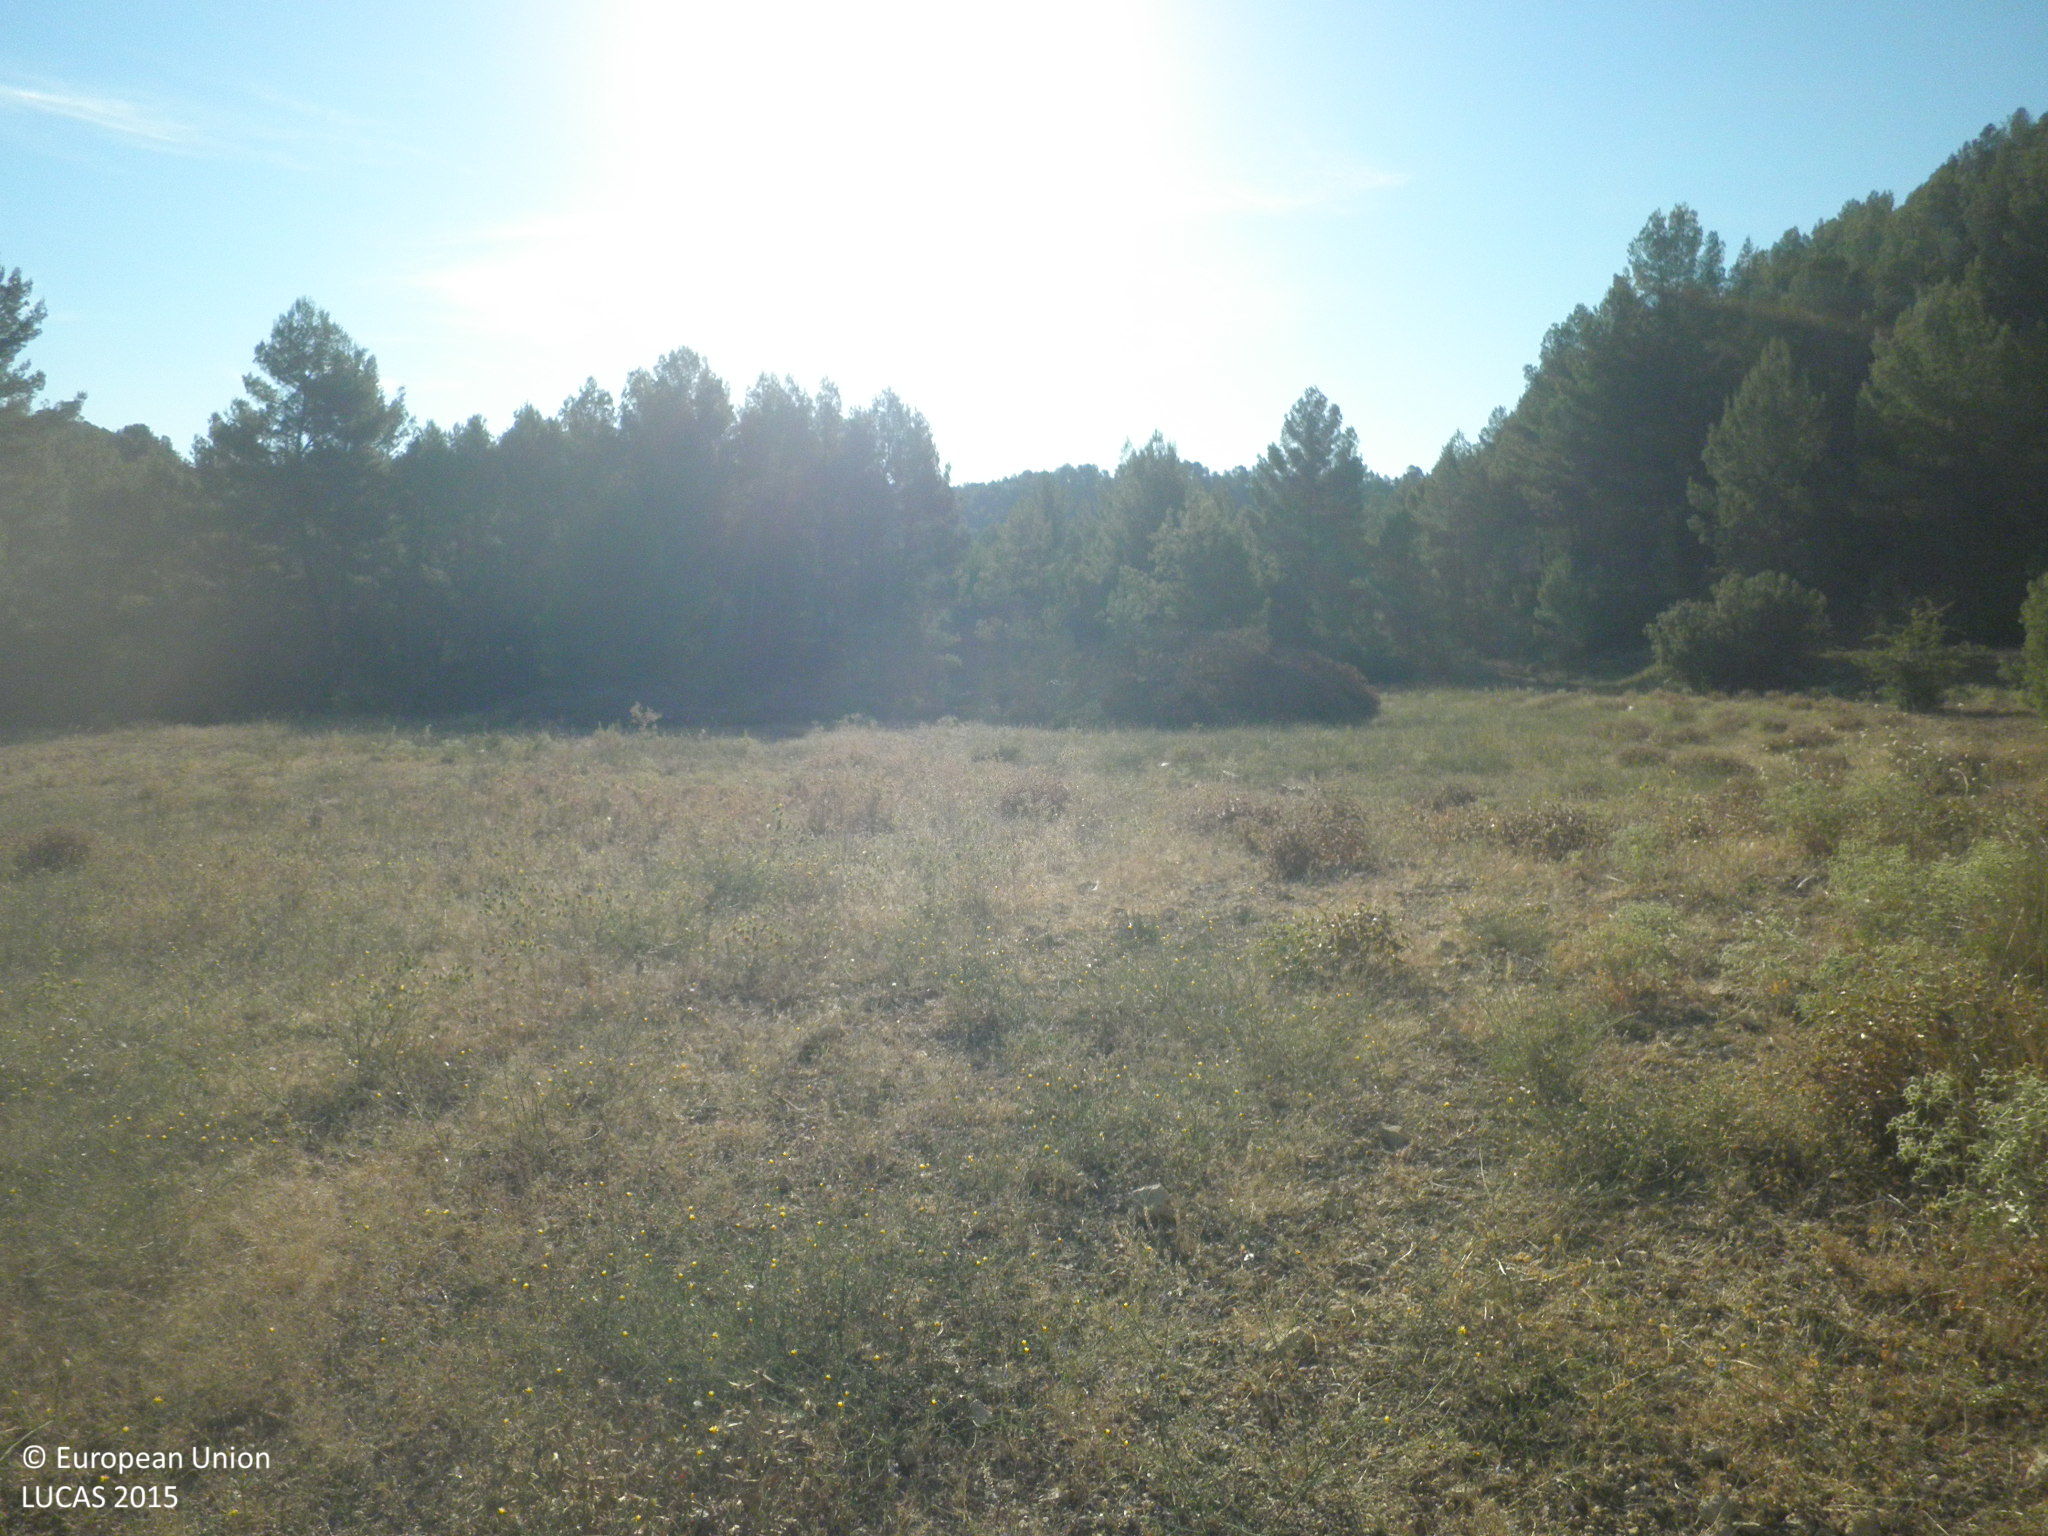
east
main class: Grassland
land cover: Grassland with sparse tree/shrub cover
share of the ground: > 75 %
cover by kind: herbaceous plants 75 %, unconsolidated bare surface 15 %, coniferous forest trees 5 %, shrubs 5 %
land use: Semi-natural and natural areas not in use
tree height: > 5 m
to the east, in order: Grassland with sparse tree/shrub cover; Tracks; Grassland without tree/shrub cover; Pine dominated coniferous woodland; Dry stone walls; Grassland with sparse tree/shrub cover; Dry stone walls; Grassland with sparse tree/shrub cover; Tracks; Grassland with sparse tree/shrub cover; Other bare soil; Pine dominated coniferous woodland
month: July
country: ES
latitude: 39.4680
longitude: -1.5930
